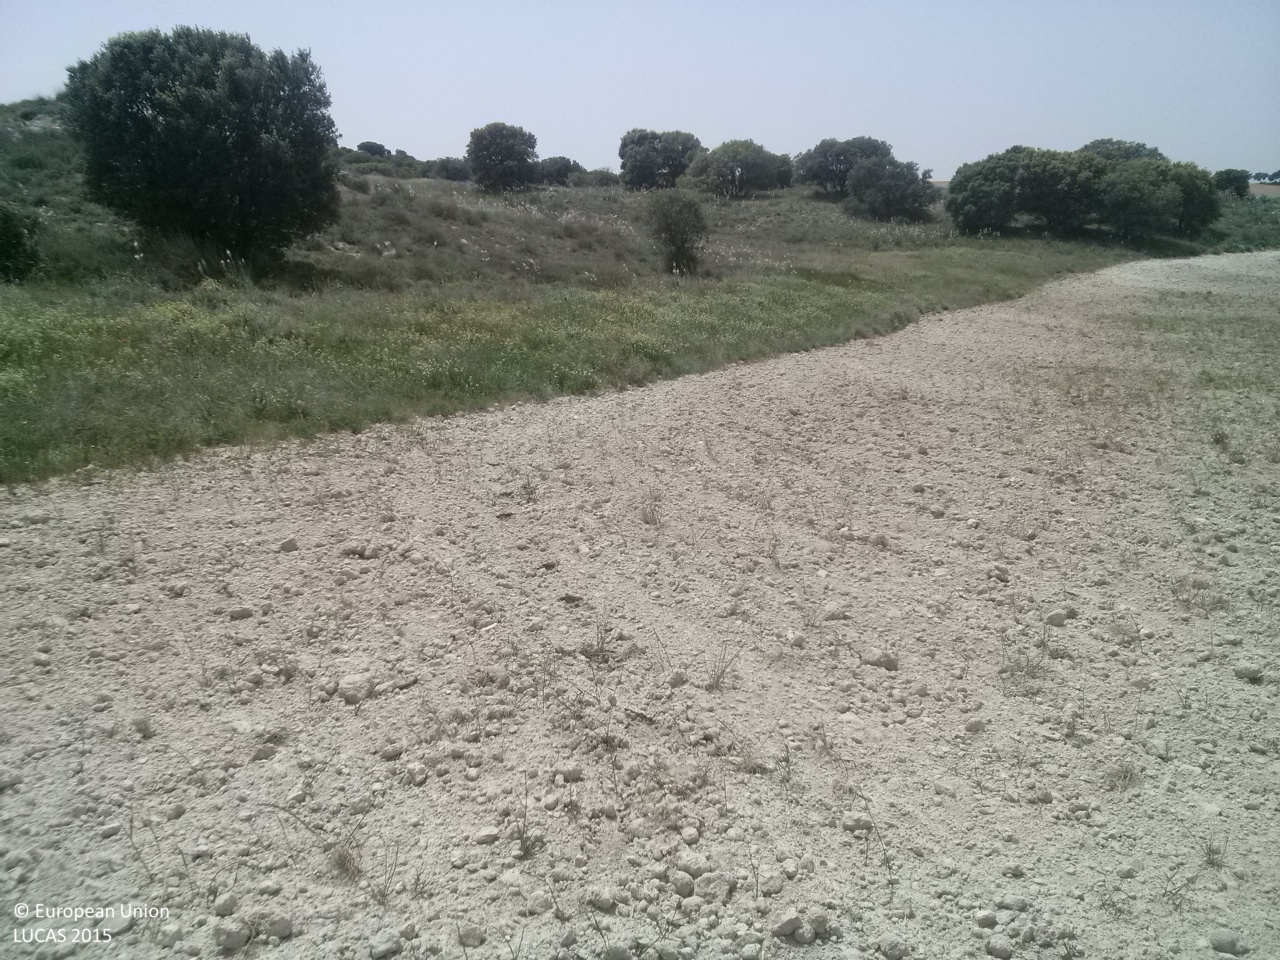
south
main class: Grassland
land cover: Spontaneously vegetated surfaces
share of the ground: < 10 %
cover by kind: unconsolidated bare surface 90 %, herbaceous plants 10 %
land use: Fallow land
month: May
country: ES
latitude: 39.9154
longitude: -2.6891
